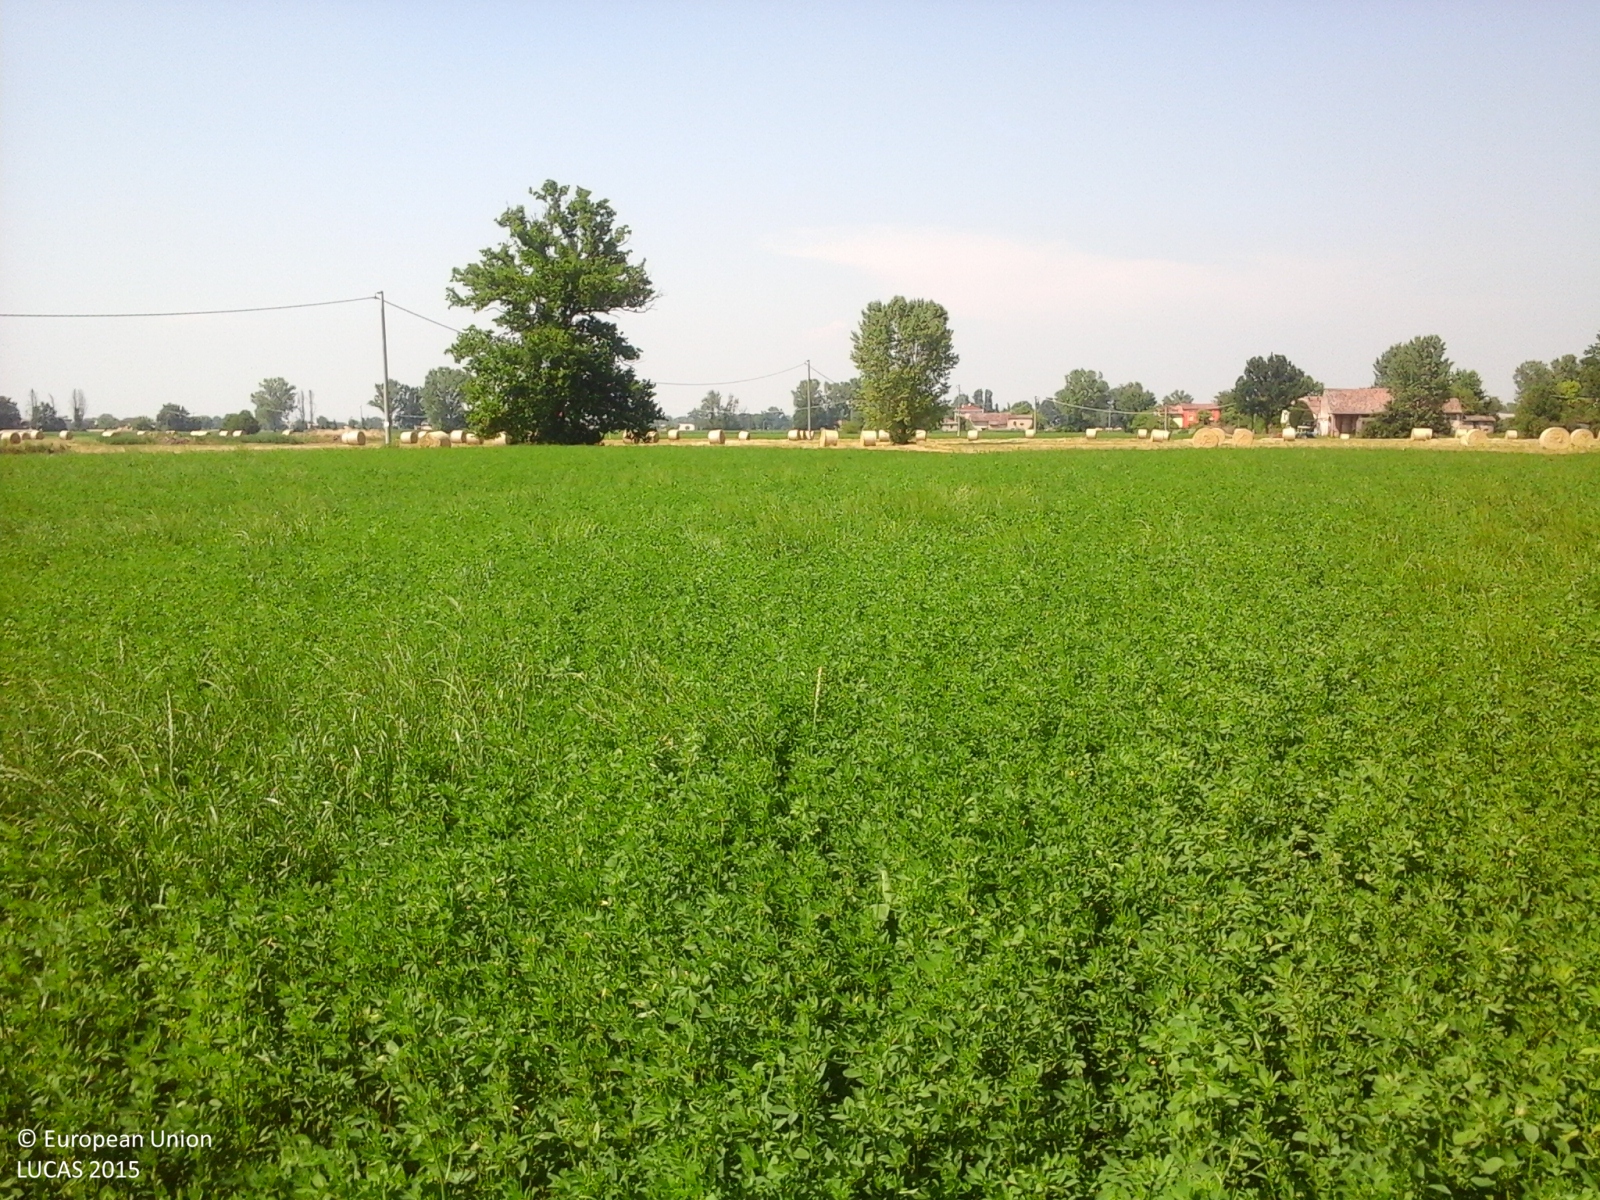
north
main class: Cropland
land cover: Lucerne
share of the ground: > 75 %
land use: Agriculture (excluding fallow land and kitchen gardens)
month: June
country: IT
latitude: 44.9276
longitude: 10.0632
